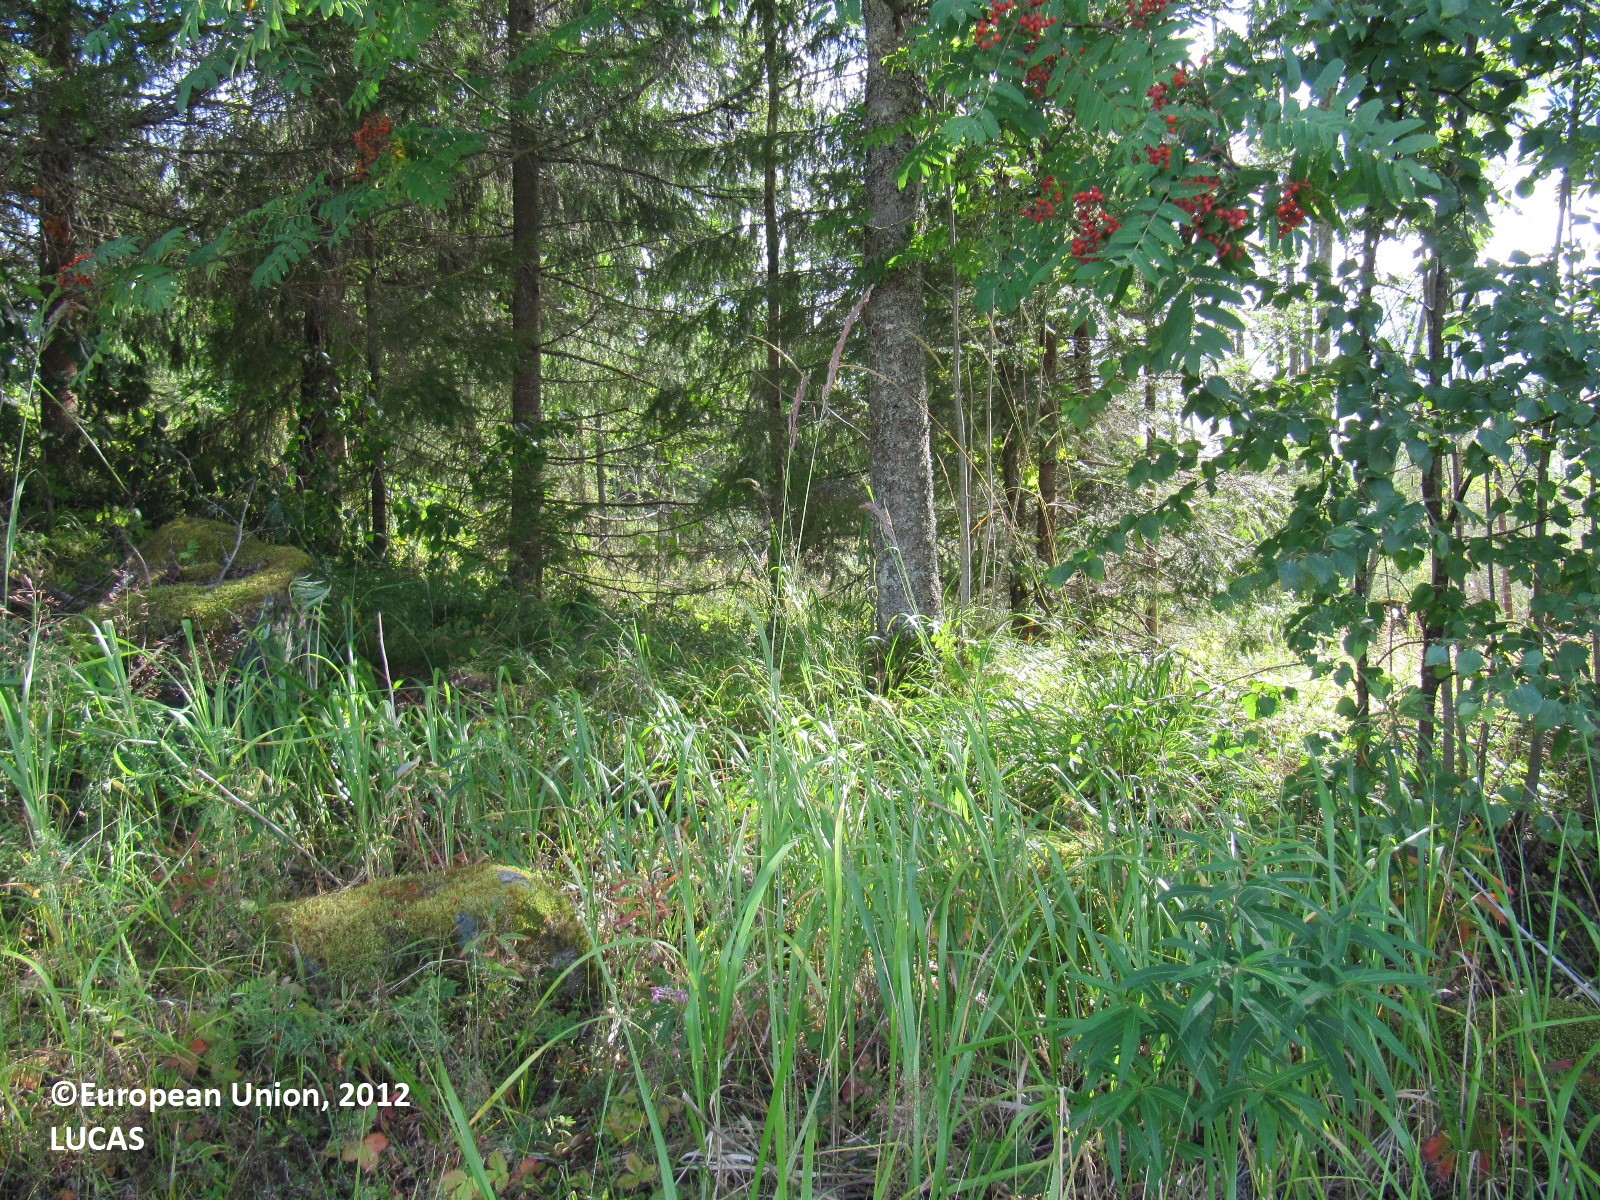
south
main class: Cropland
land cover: Oats
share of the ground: > 75 %
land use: Agriculture (excluding fallow land and kitchen gardens)
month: August
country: FI
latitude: 60.6451
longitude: 24.4225
